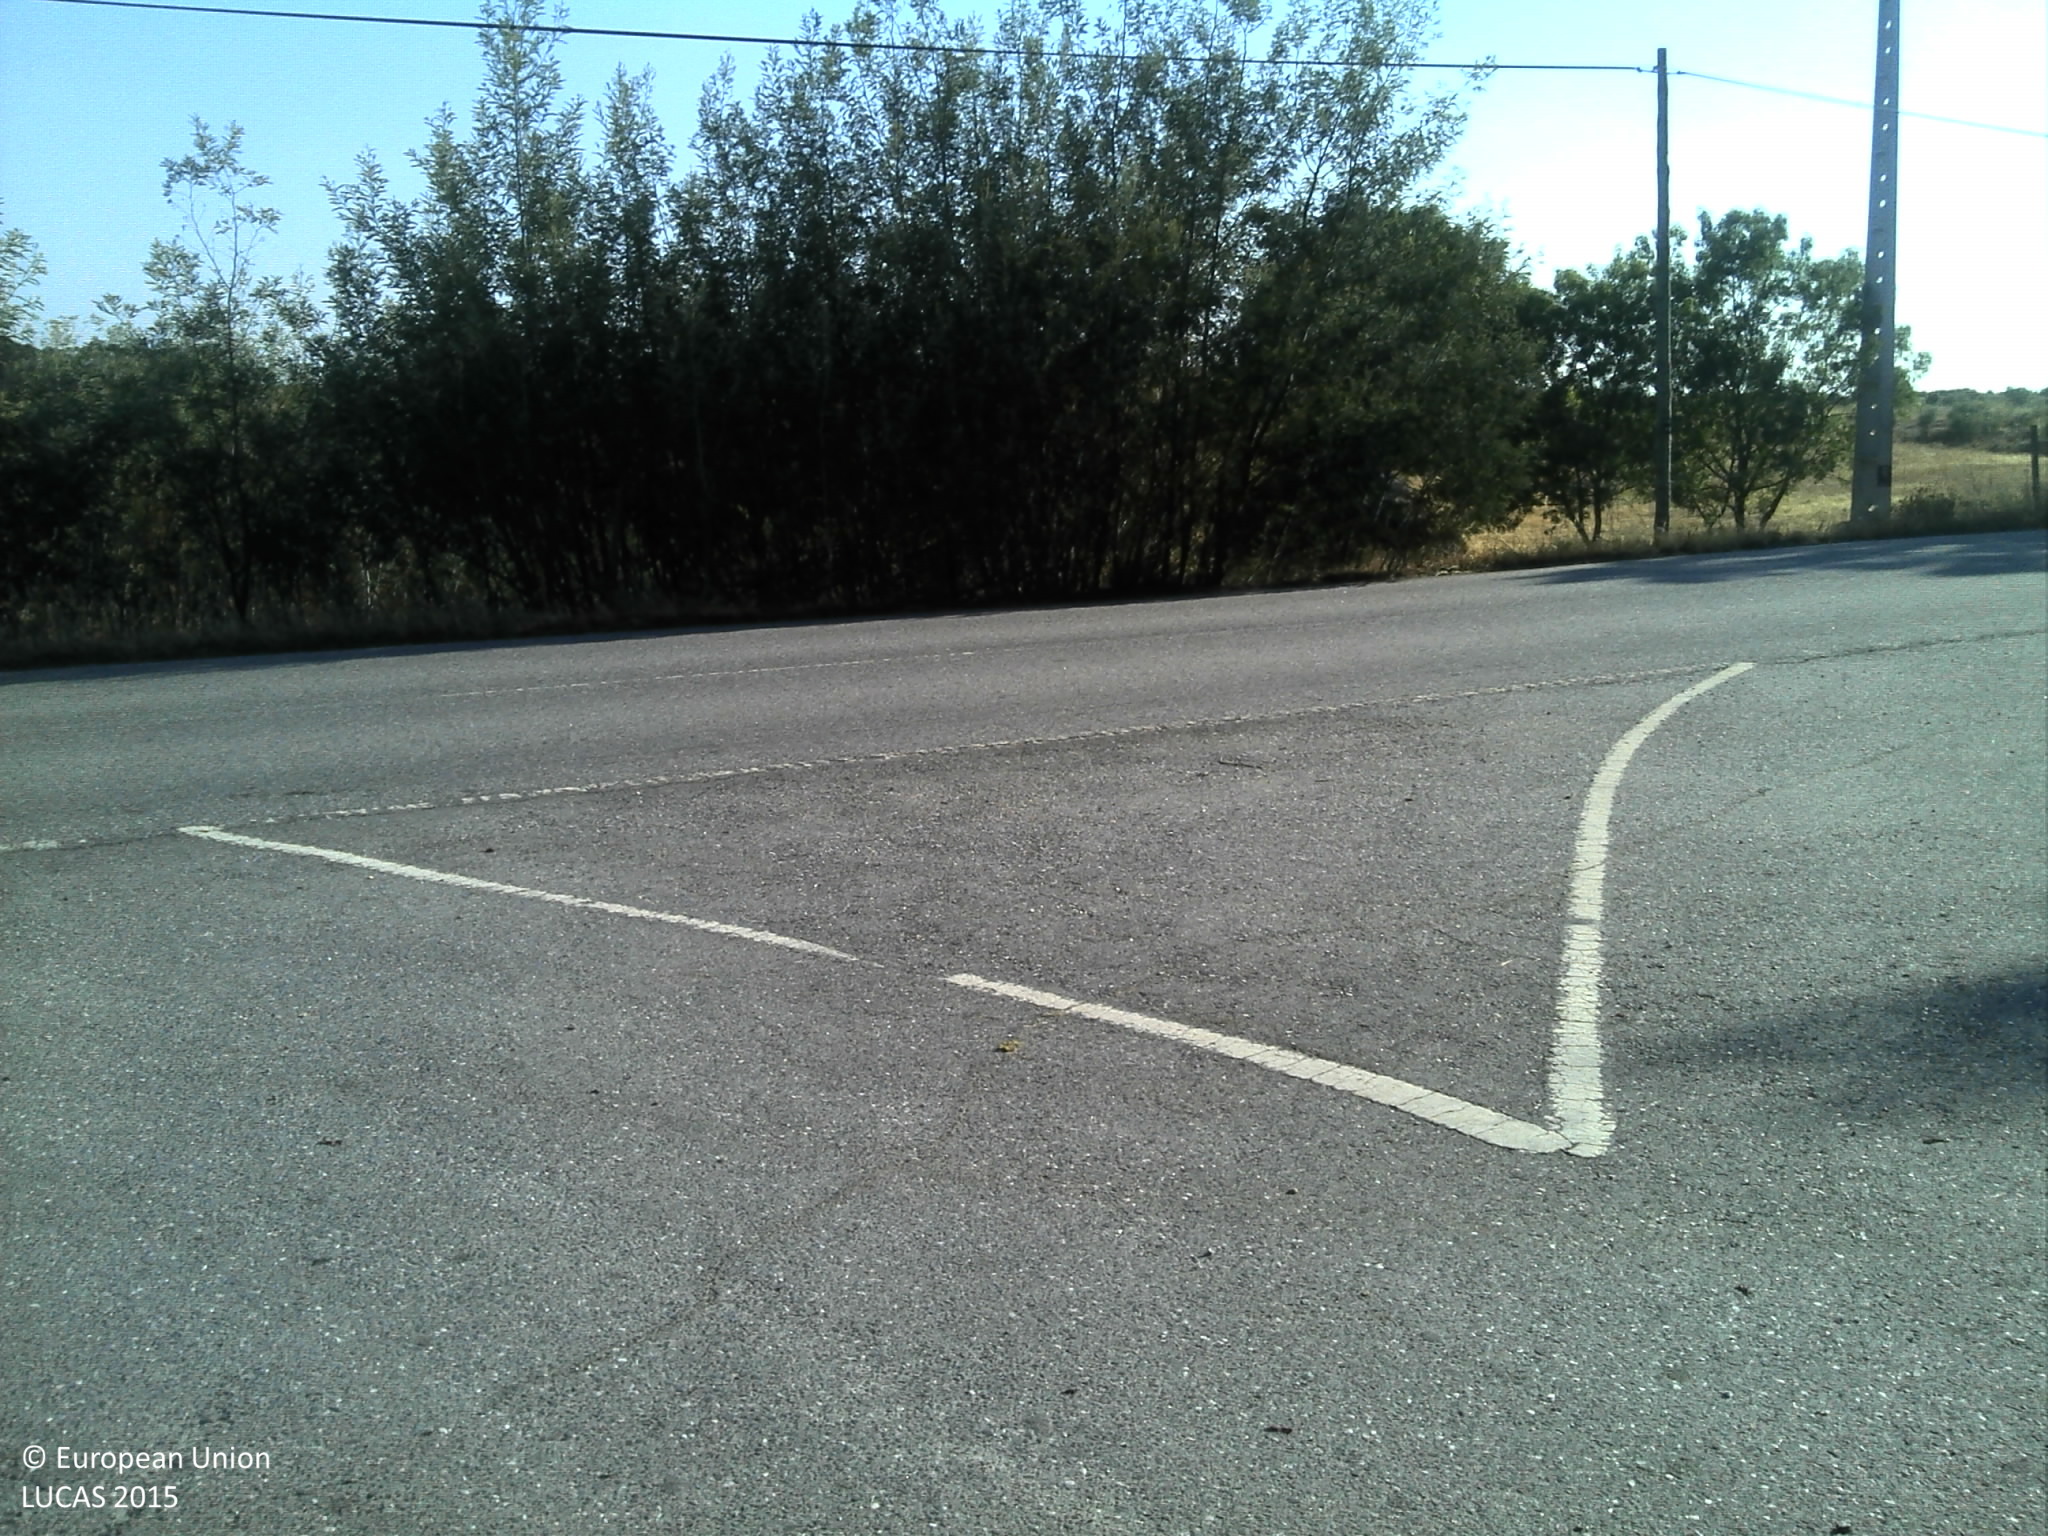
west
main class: Woodland
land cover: Broadleaved woodland
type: broadleaved evergreen forest
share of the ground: 25 - 50 %
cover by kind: broadleaved forest trees 40 %, unconsolidated bare surface 40 %, herbaceous plants 20 %
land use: Forestry
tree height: > 5 m
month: June
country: PT
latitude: 39.9519
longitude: -7.4111
